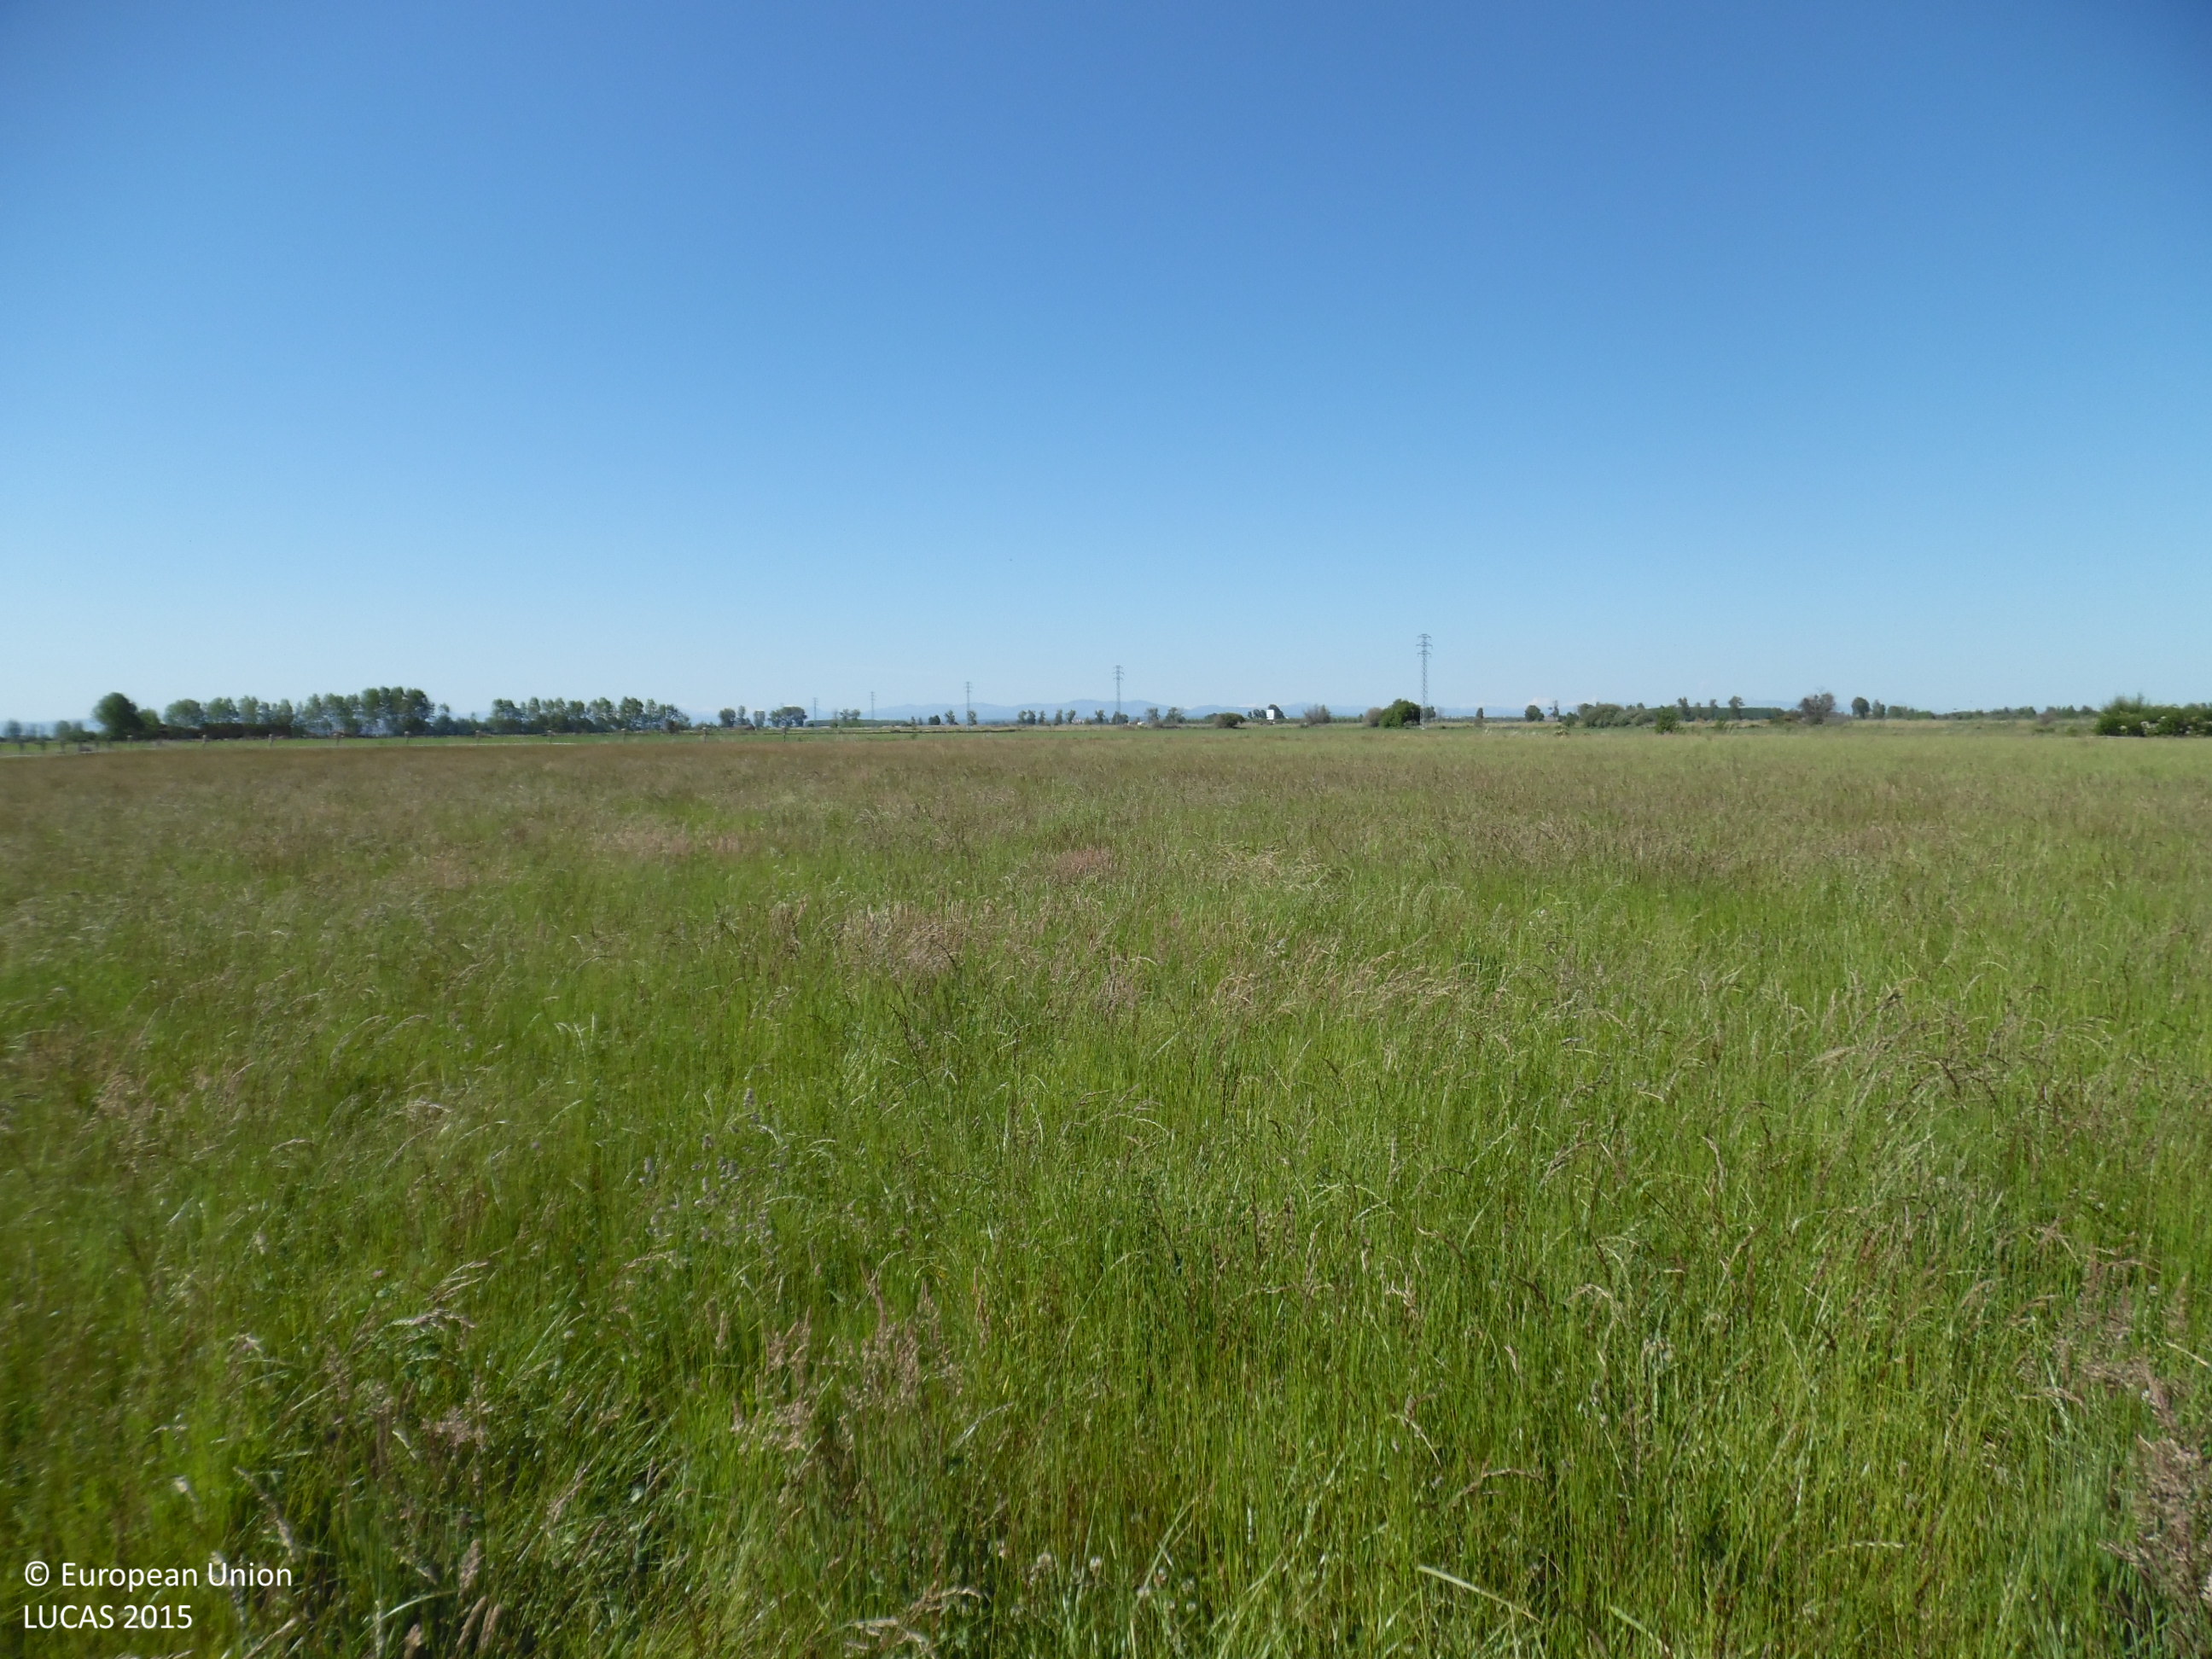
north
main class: Cropland
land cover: Other leguminous and mixtures for fodder
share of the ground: > 75 %
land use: Agriculture (excluding fallow land and kitchen gardens)
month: June
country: ES
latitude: 42.4381
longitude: -5.7691
